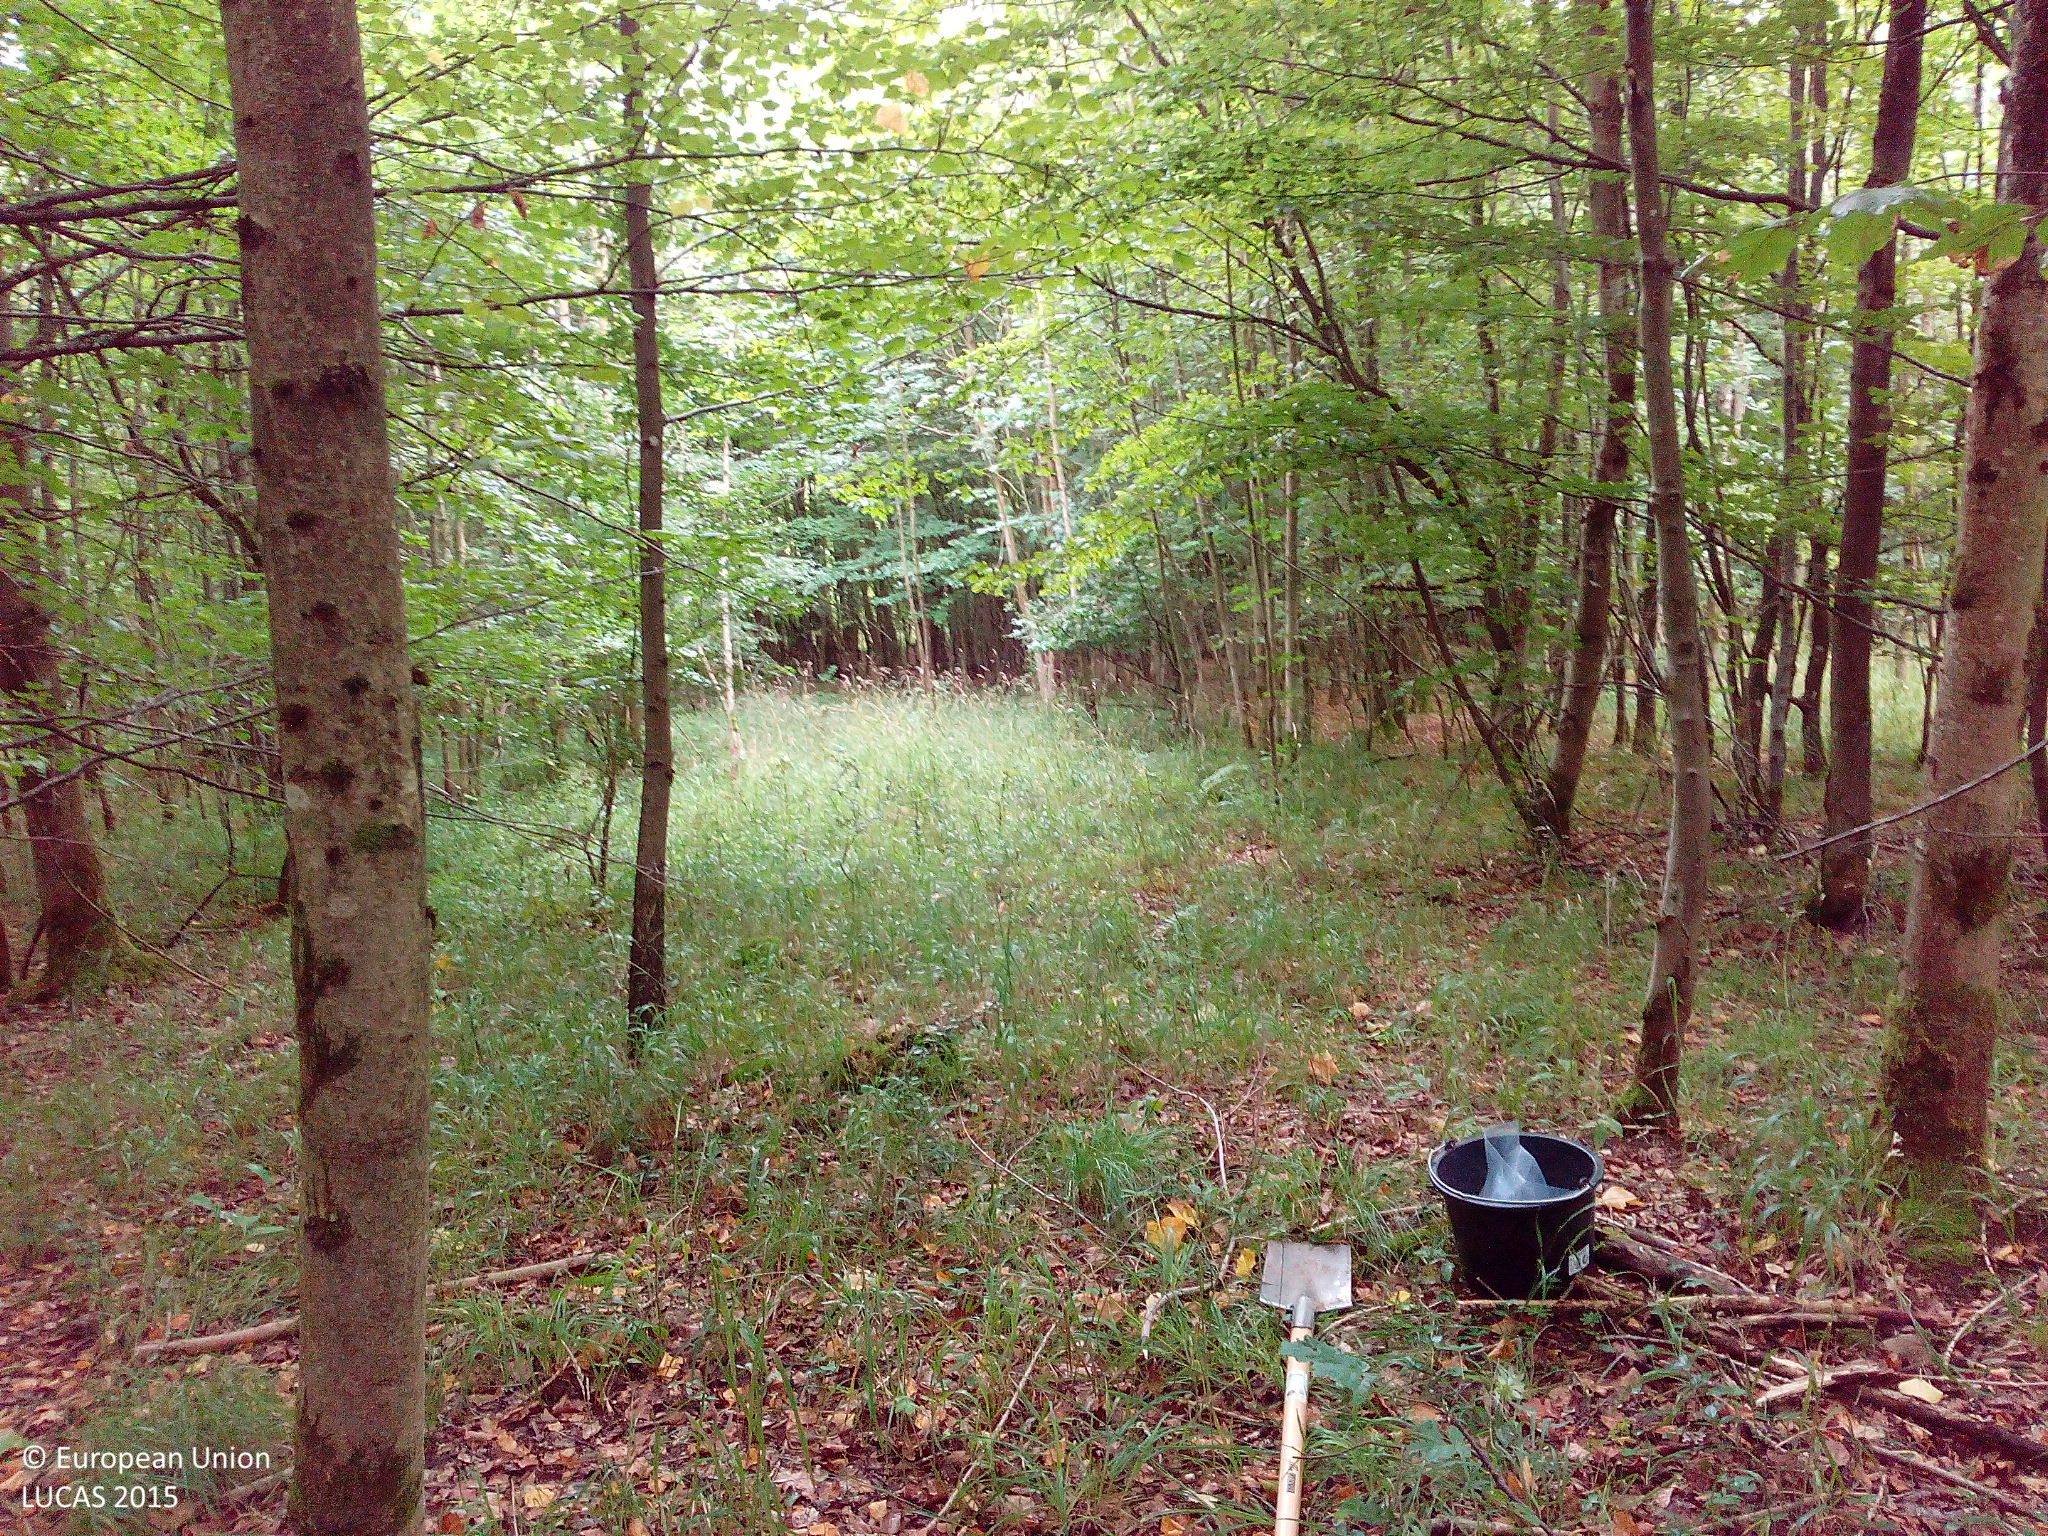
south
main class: Woodland
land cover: Broadleaved woodland
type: beech forest
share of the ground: > 75 %
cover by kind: broadleaved forest trees 100 %
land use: Forestry
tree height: > 5 m
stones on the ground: < 10 %
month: August
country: DE
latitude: 50.6317
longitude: 9.3075
